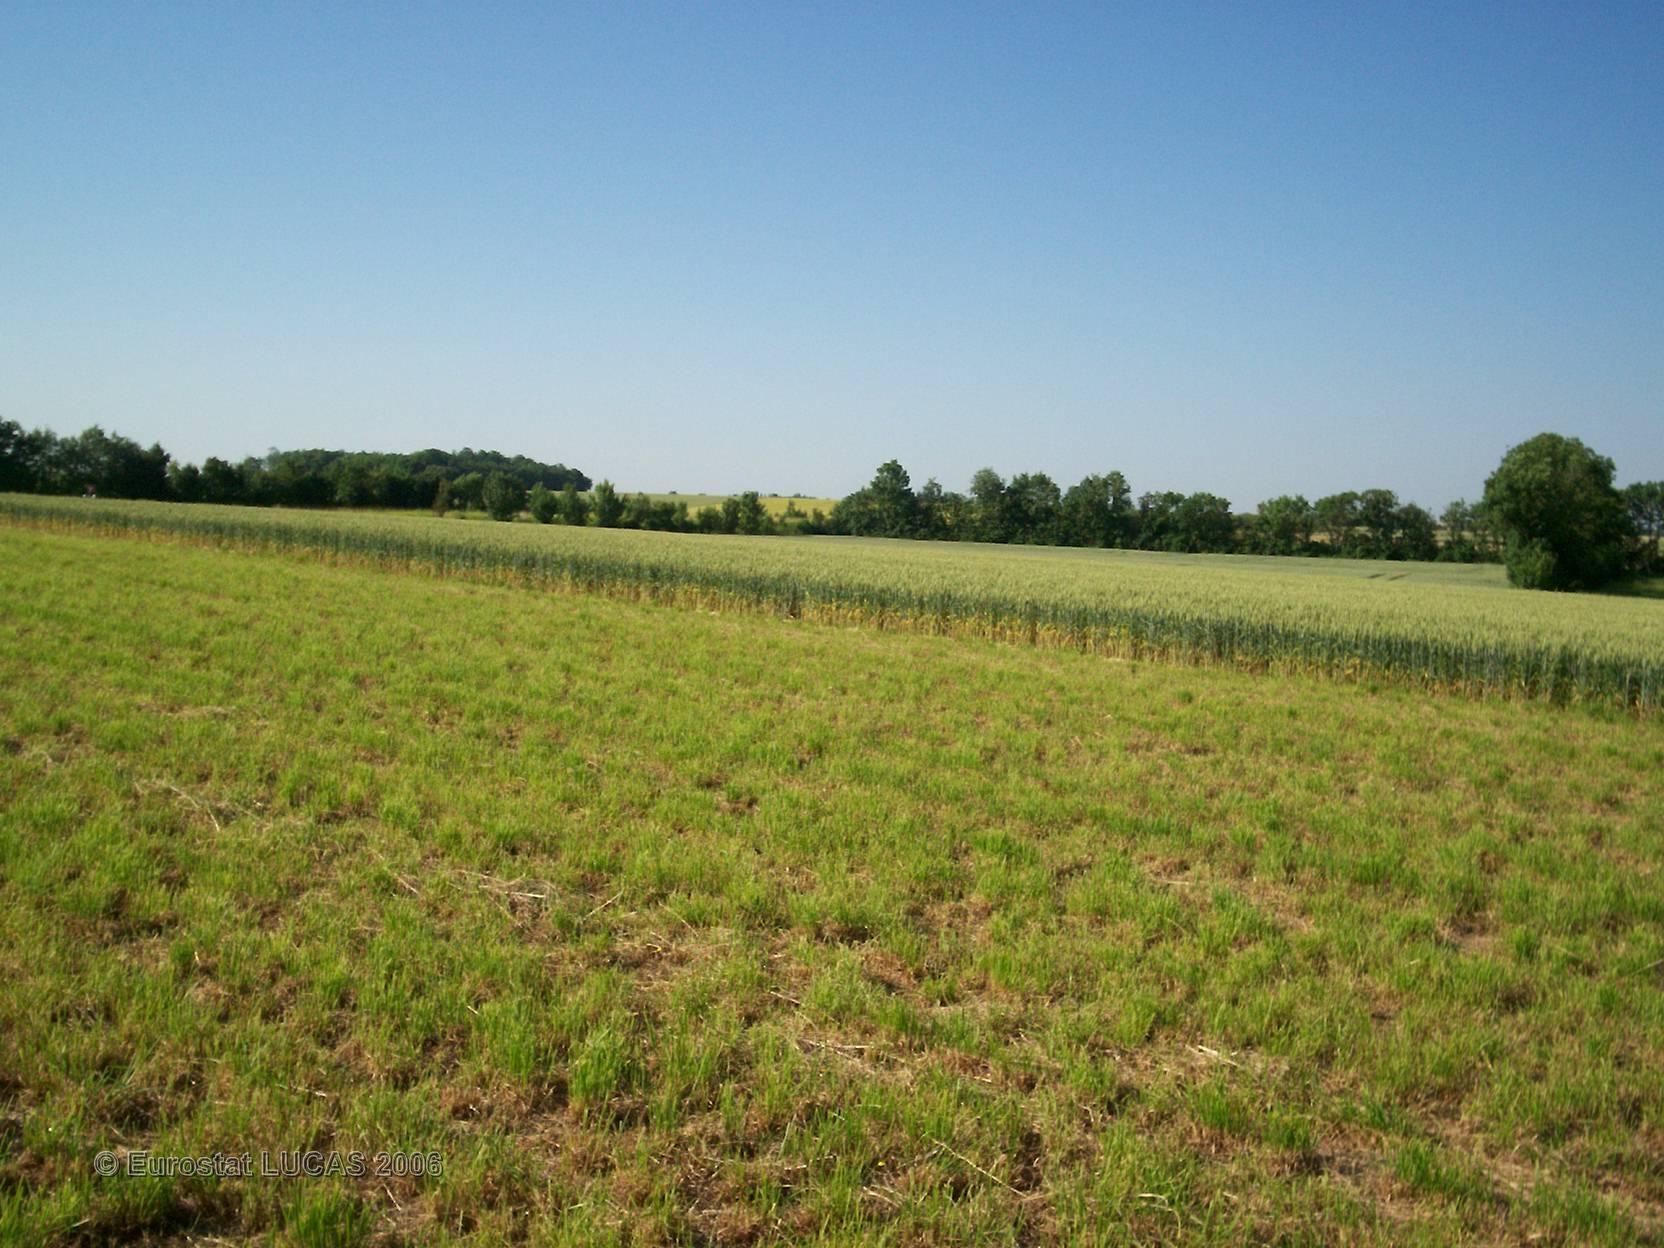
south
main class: Grassland
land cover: Grassland without tree/shrub cover
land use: Agriculture (excluding fallow land and kitchen gardens)
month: June
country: FR
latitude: 46.1570
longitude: -0.7100
